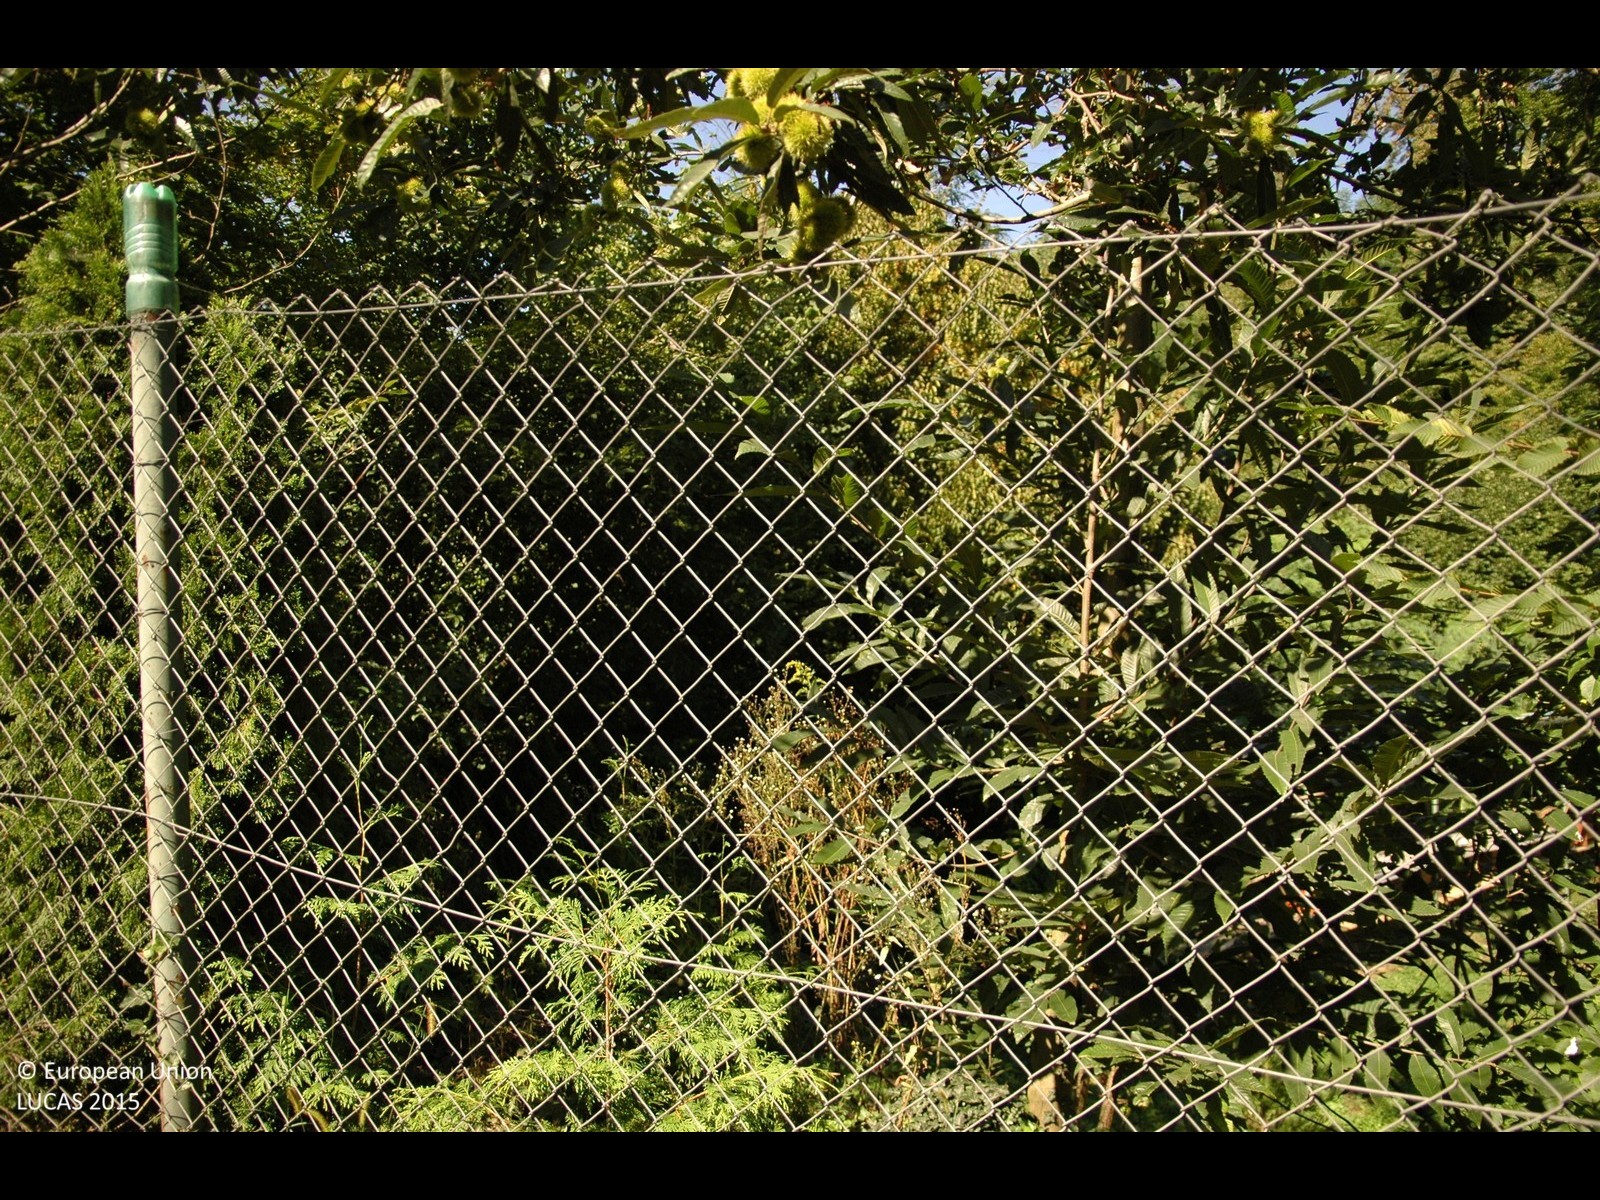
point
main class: Woodland
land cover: Broadleaved woodland
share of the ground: > 75 %
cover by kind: broadleaved forest trees 100 %
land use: Semi-natural and natural areas not in use
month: August
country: HR
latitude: 46.1724
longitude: 16.7753
